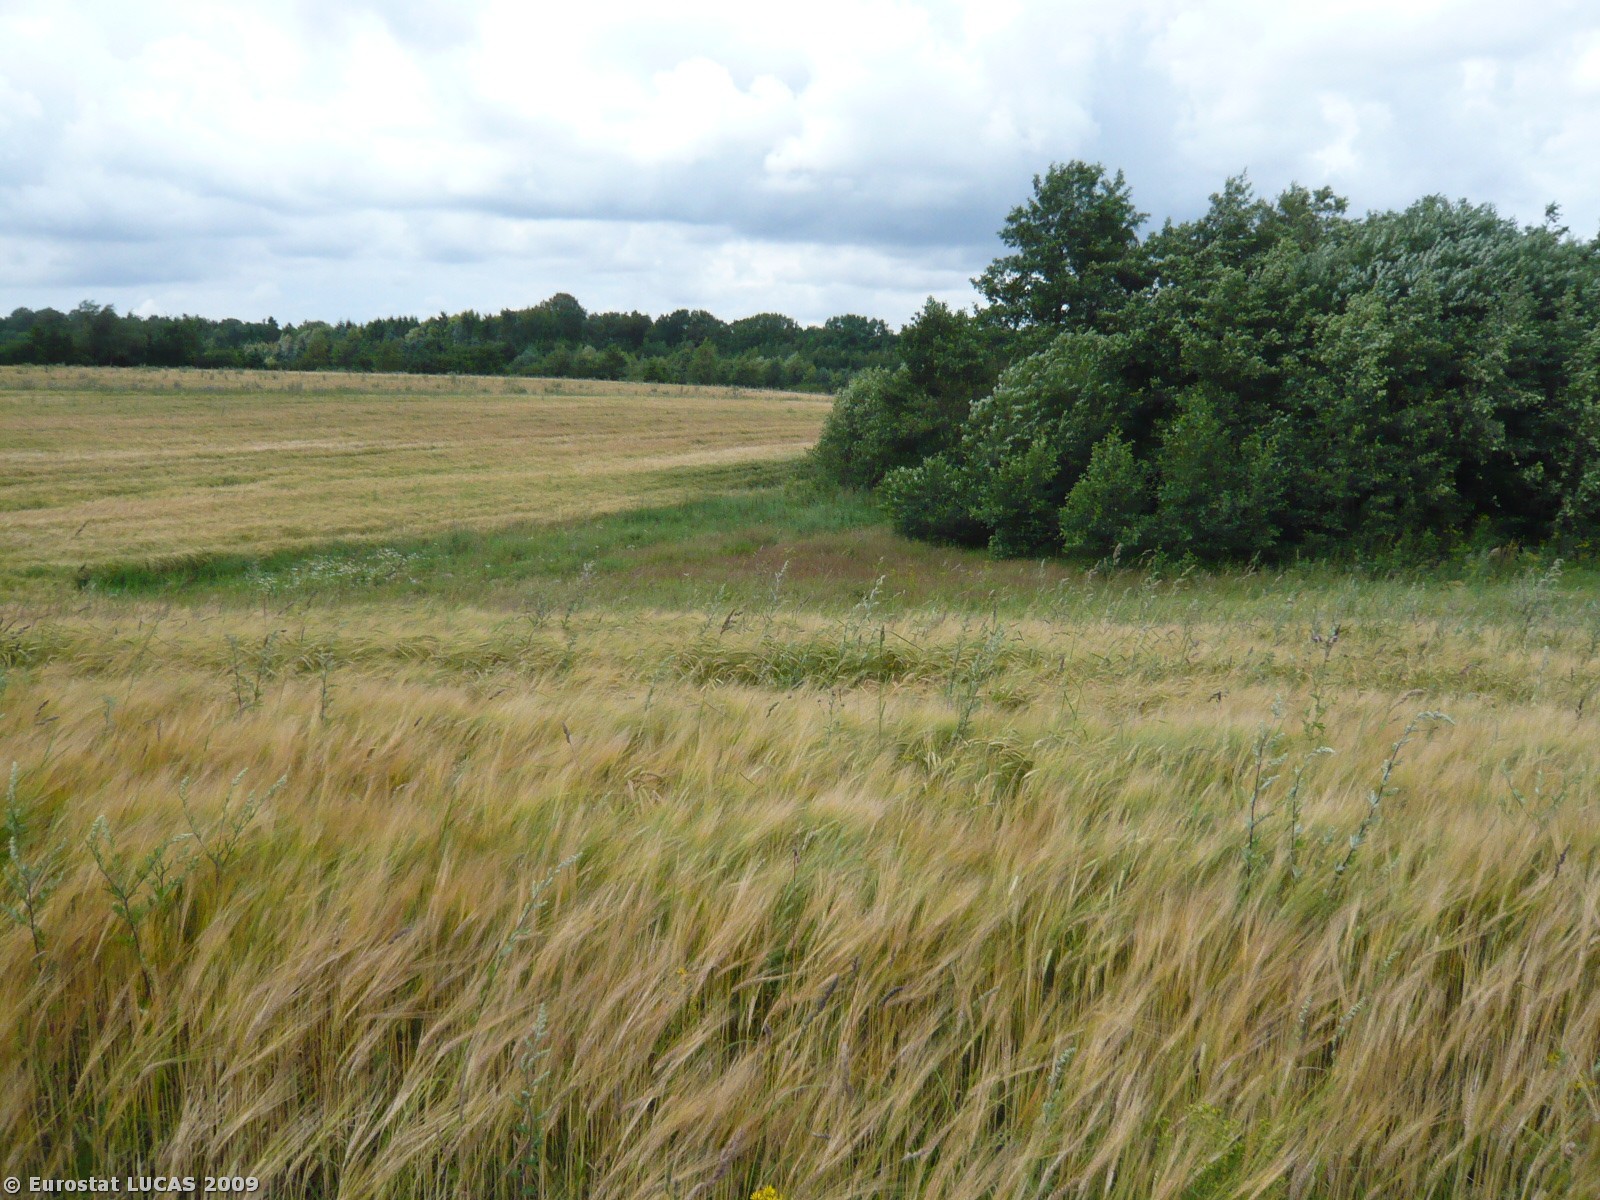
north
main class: Cropland
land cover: Barley
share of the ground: > 75 %
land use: Agriculture (excluding fallow land and kitchen gardens)
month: July
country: DK
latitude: 55.5082
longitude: 11.9143
